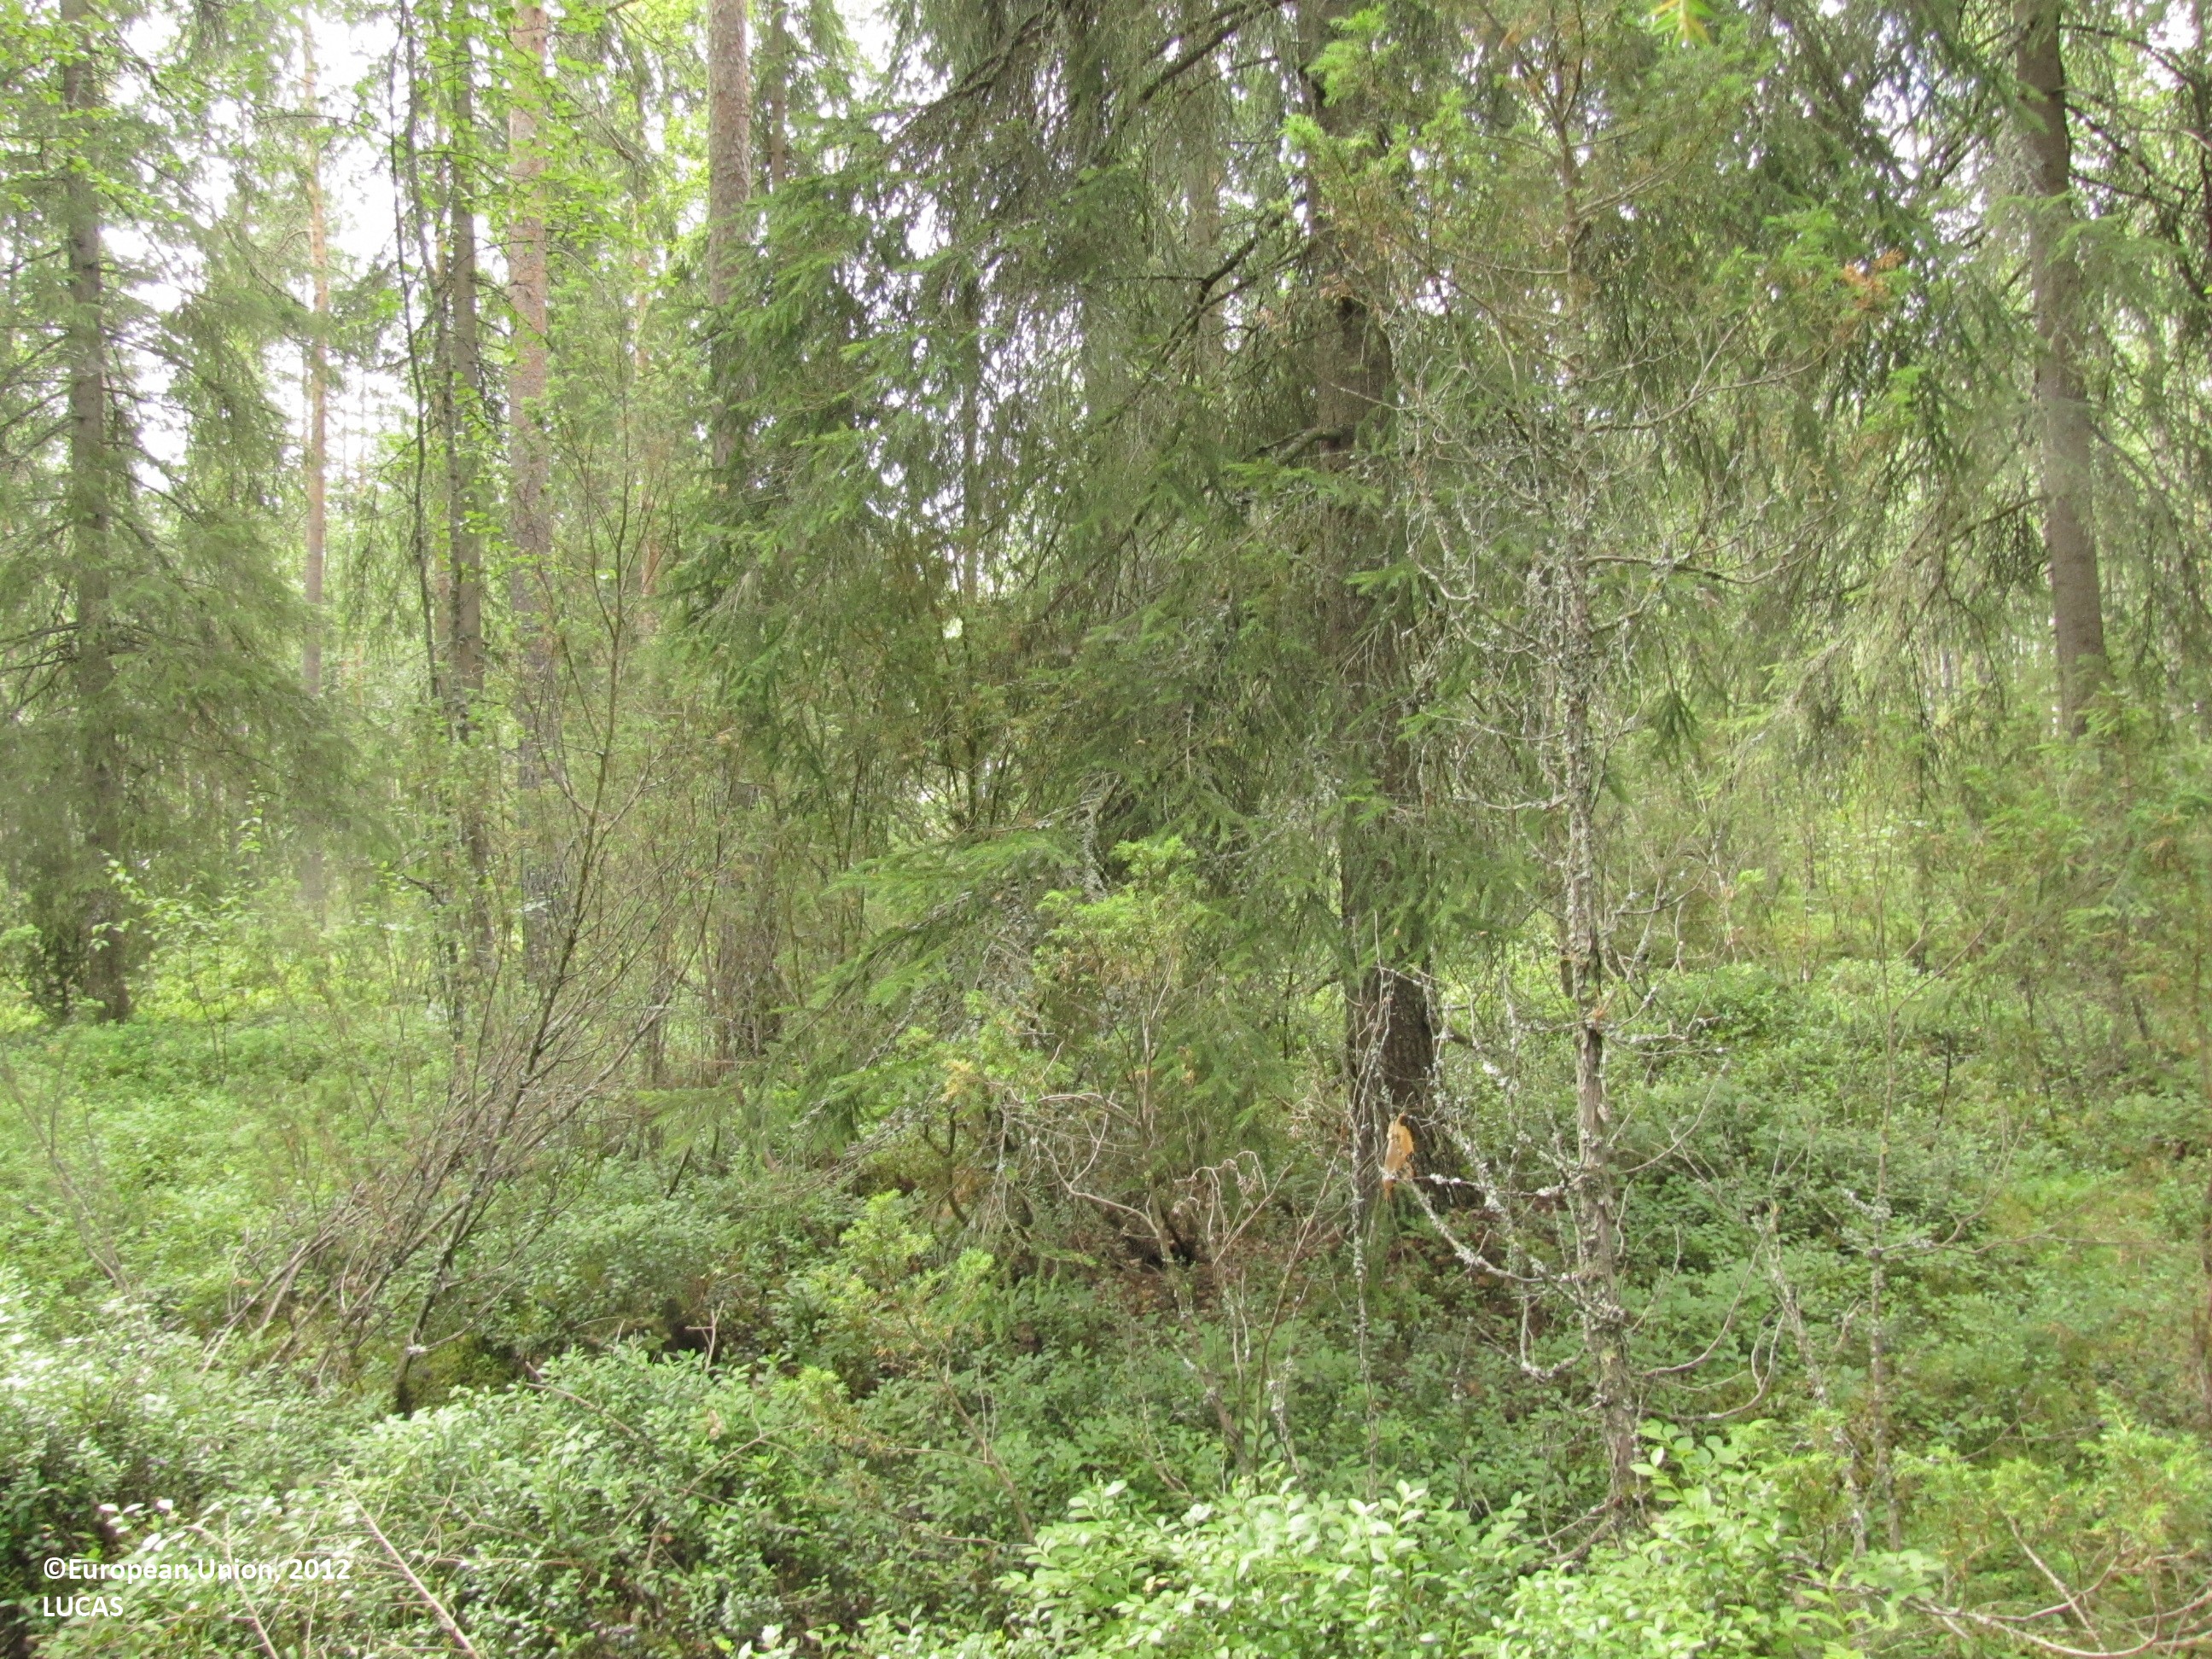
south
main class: Woodland
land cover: Other mixed woodland
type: boreal forest
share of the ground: > 75 %
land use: Forestry
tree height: > 5 m
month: July
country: FI
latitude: 62.6363
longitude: 22.9517
